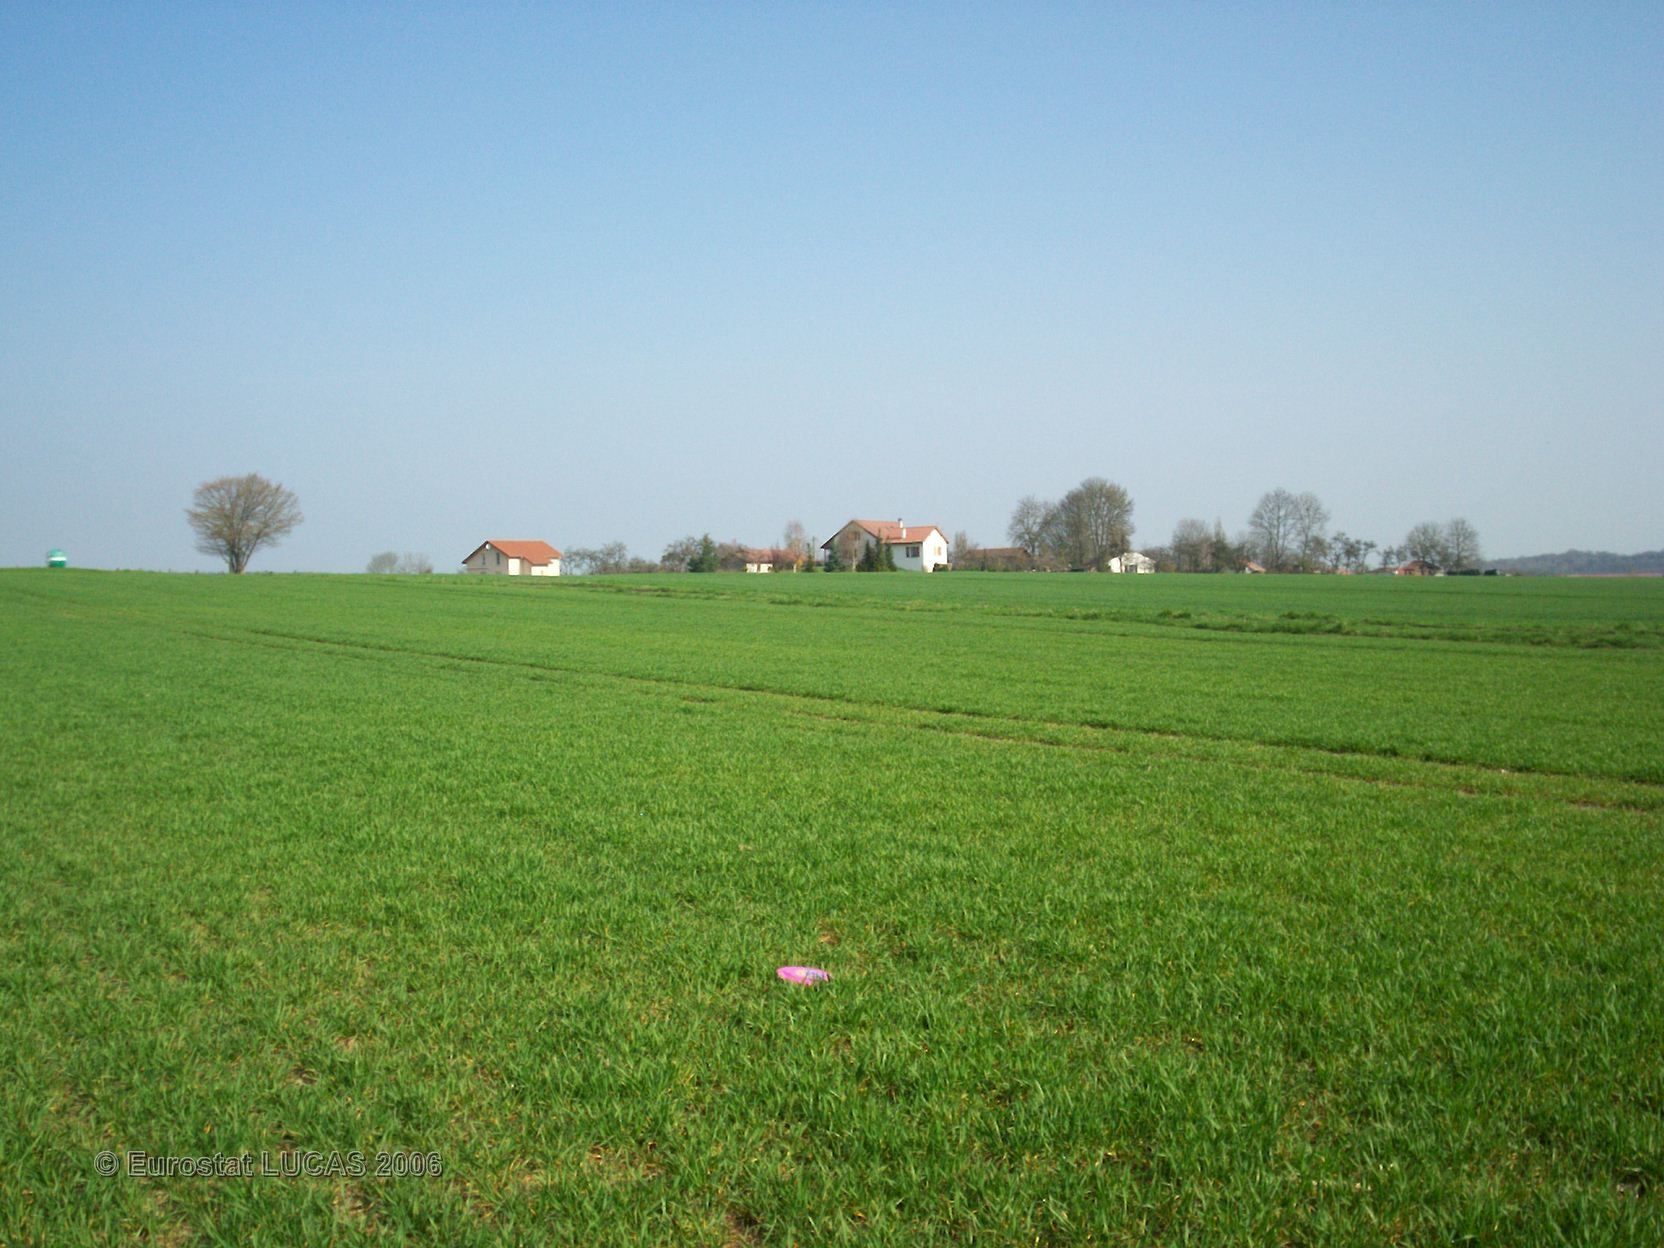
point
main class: Cropland
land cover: Common wheat
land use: Agriculture (excluding fallow land and kitchen gardens)
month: April
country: FR
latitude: 48.2234
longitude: 6.5414
